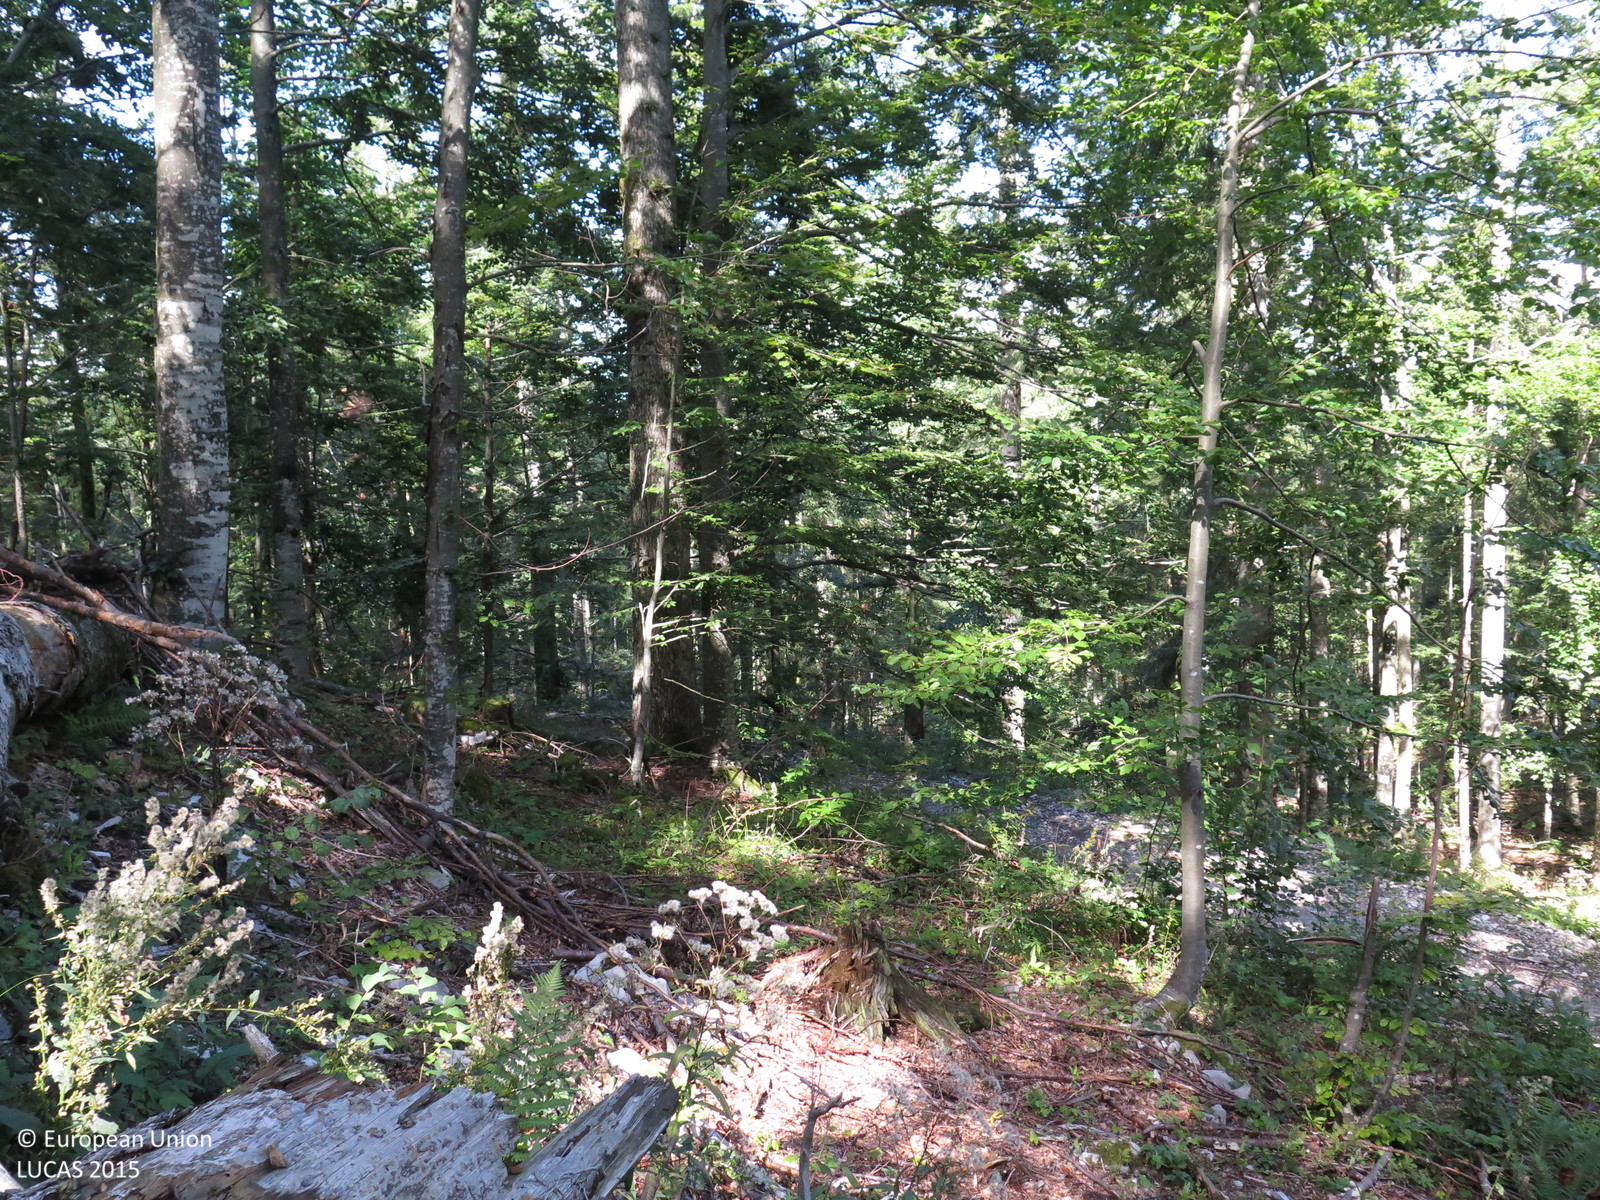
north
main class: Woodland
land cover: Other mixed woodland
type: mountainous beech forest
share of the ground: > 75 %
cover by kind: broadleaved forest trees 70 %, coniferous forest trees 25 %, unconsolidated bare surface 5 %
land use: Forestry
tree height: > 5 m
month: September
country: HR
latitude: 45.4736
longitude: 14.6643
